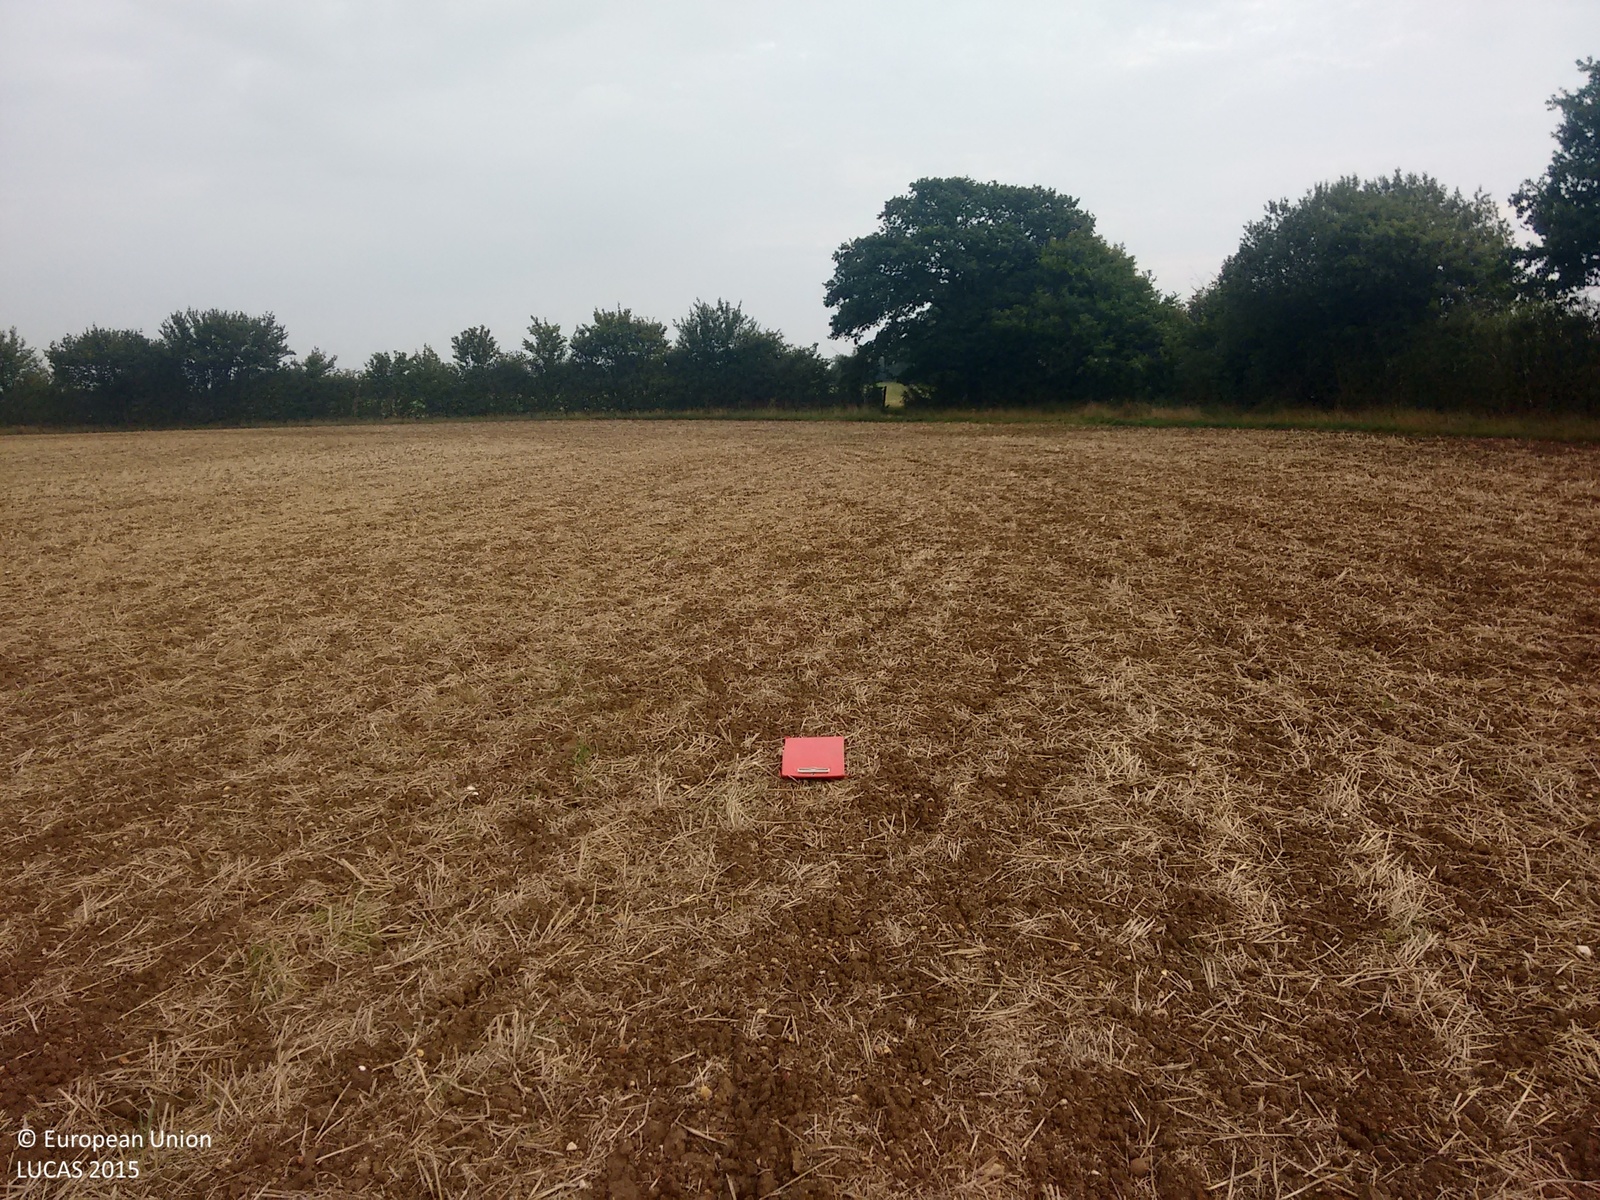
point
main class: Cropland
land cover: Oats
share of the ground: 25 - 50 %
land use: Agriculture (excluding fallow land and kitchen gardens)
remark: Harvested field
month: September
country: GB
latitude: 51.9049
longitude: 0.2752
